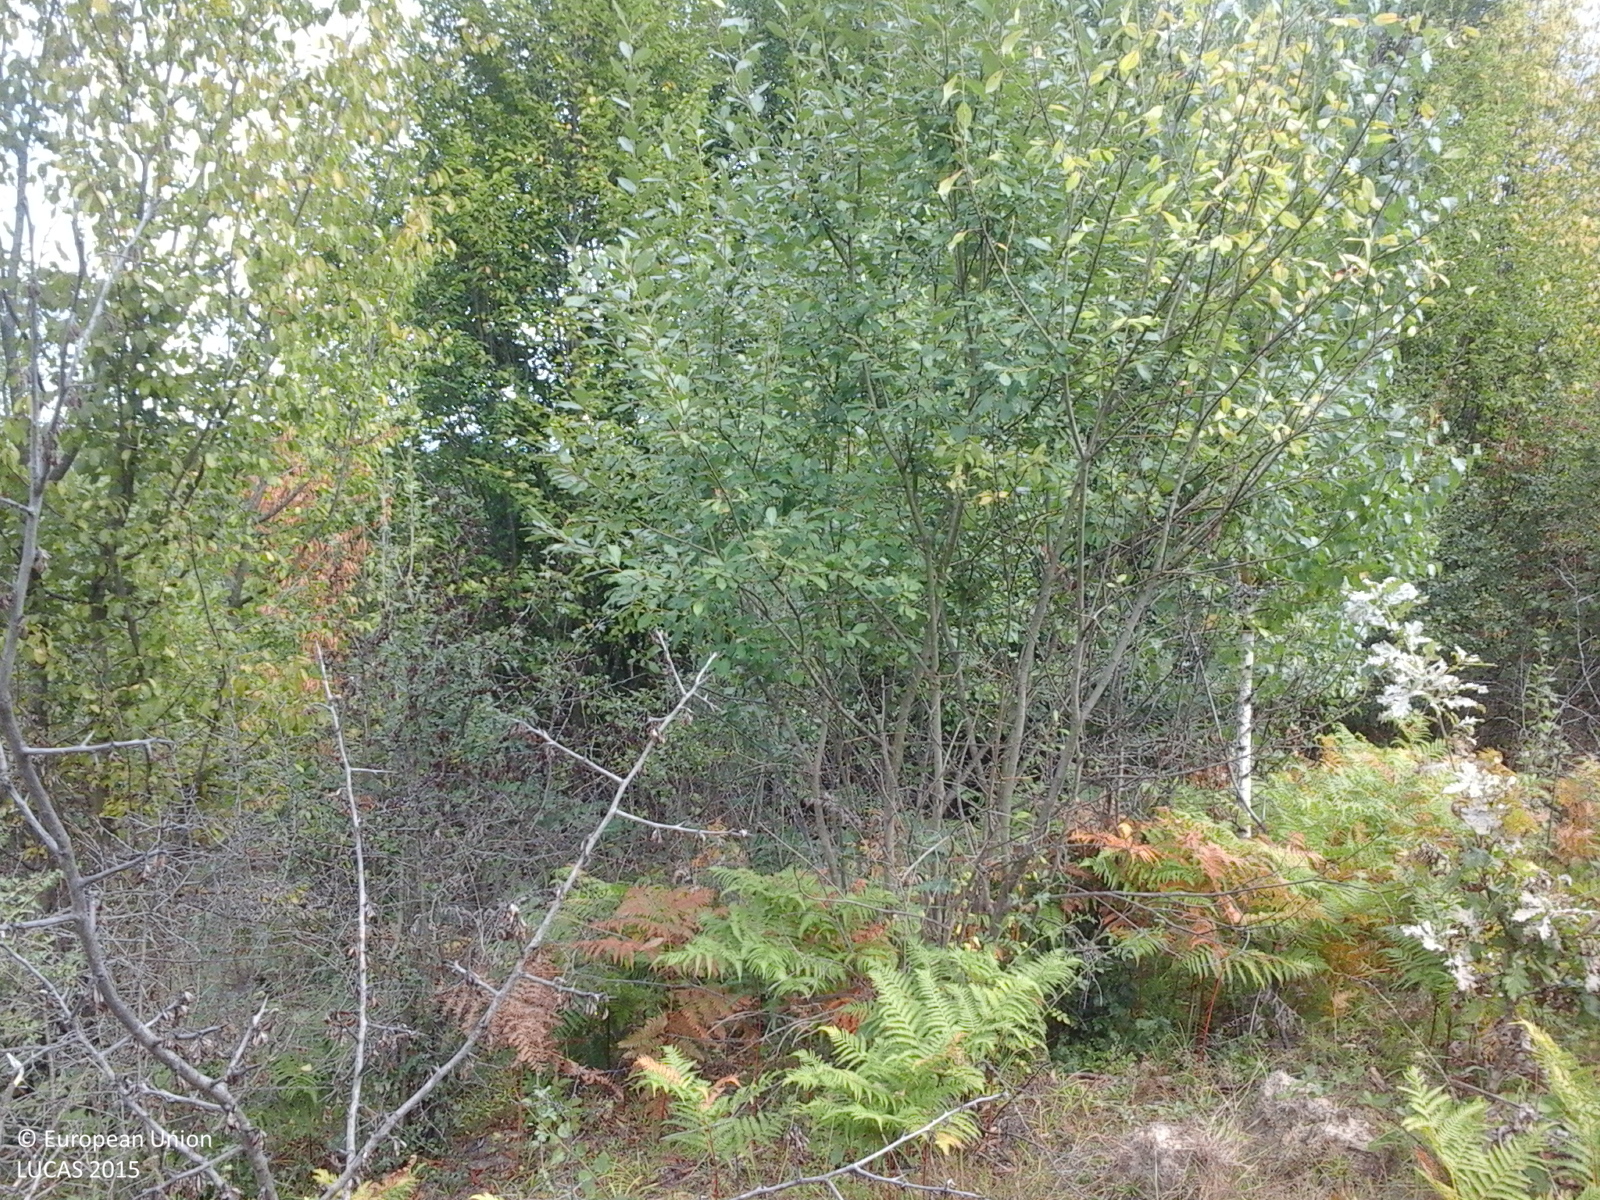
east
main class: Grassland
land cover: Grassland with sparse tree/shrub cover
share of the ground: > 75 %
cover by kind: herbaceous plants 85 %, shrubs 10 %, broadleaved forest trees 5 %
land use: Agriculture (excluding fallow land and kitchen gardens)
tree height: > 5 m
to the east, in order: Grassland with sparse tree/shrub cover; Broadleaved woodland; Grassland with sparse tree/shrub cover; Broadleaved woodland; Grassland without tree/shrub cover; Tracks; Grassland without tree/shrub cover
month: September
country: RO
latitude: 47.3284
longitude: 23.3958
